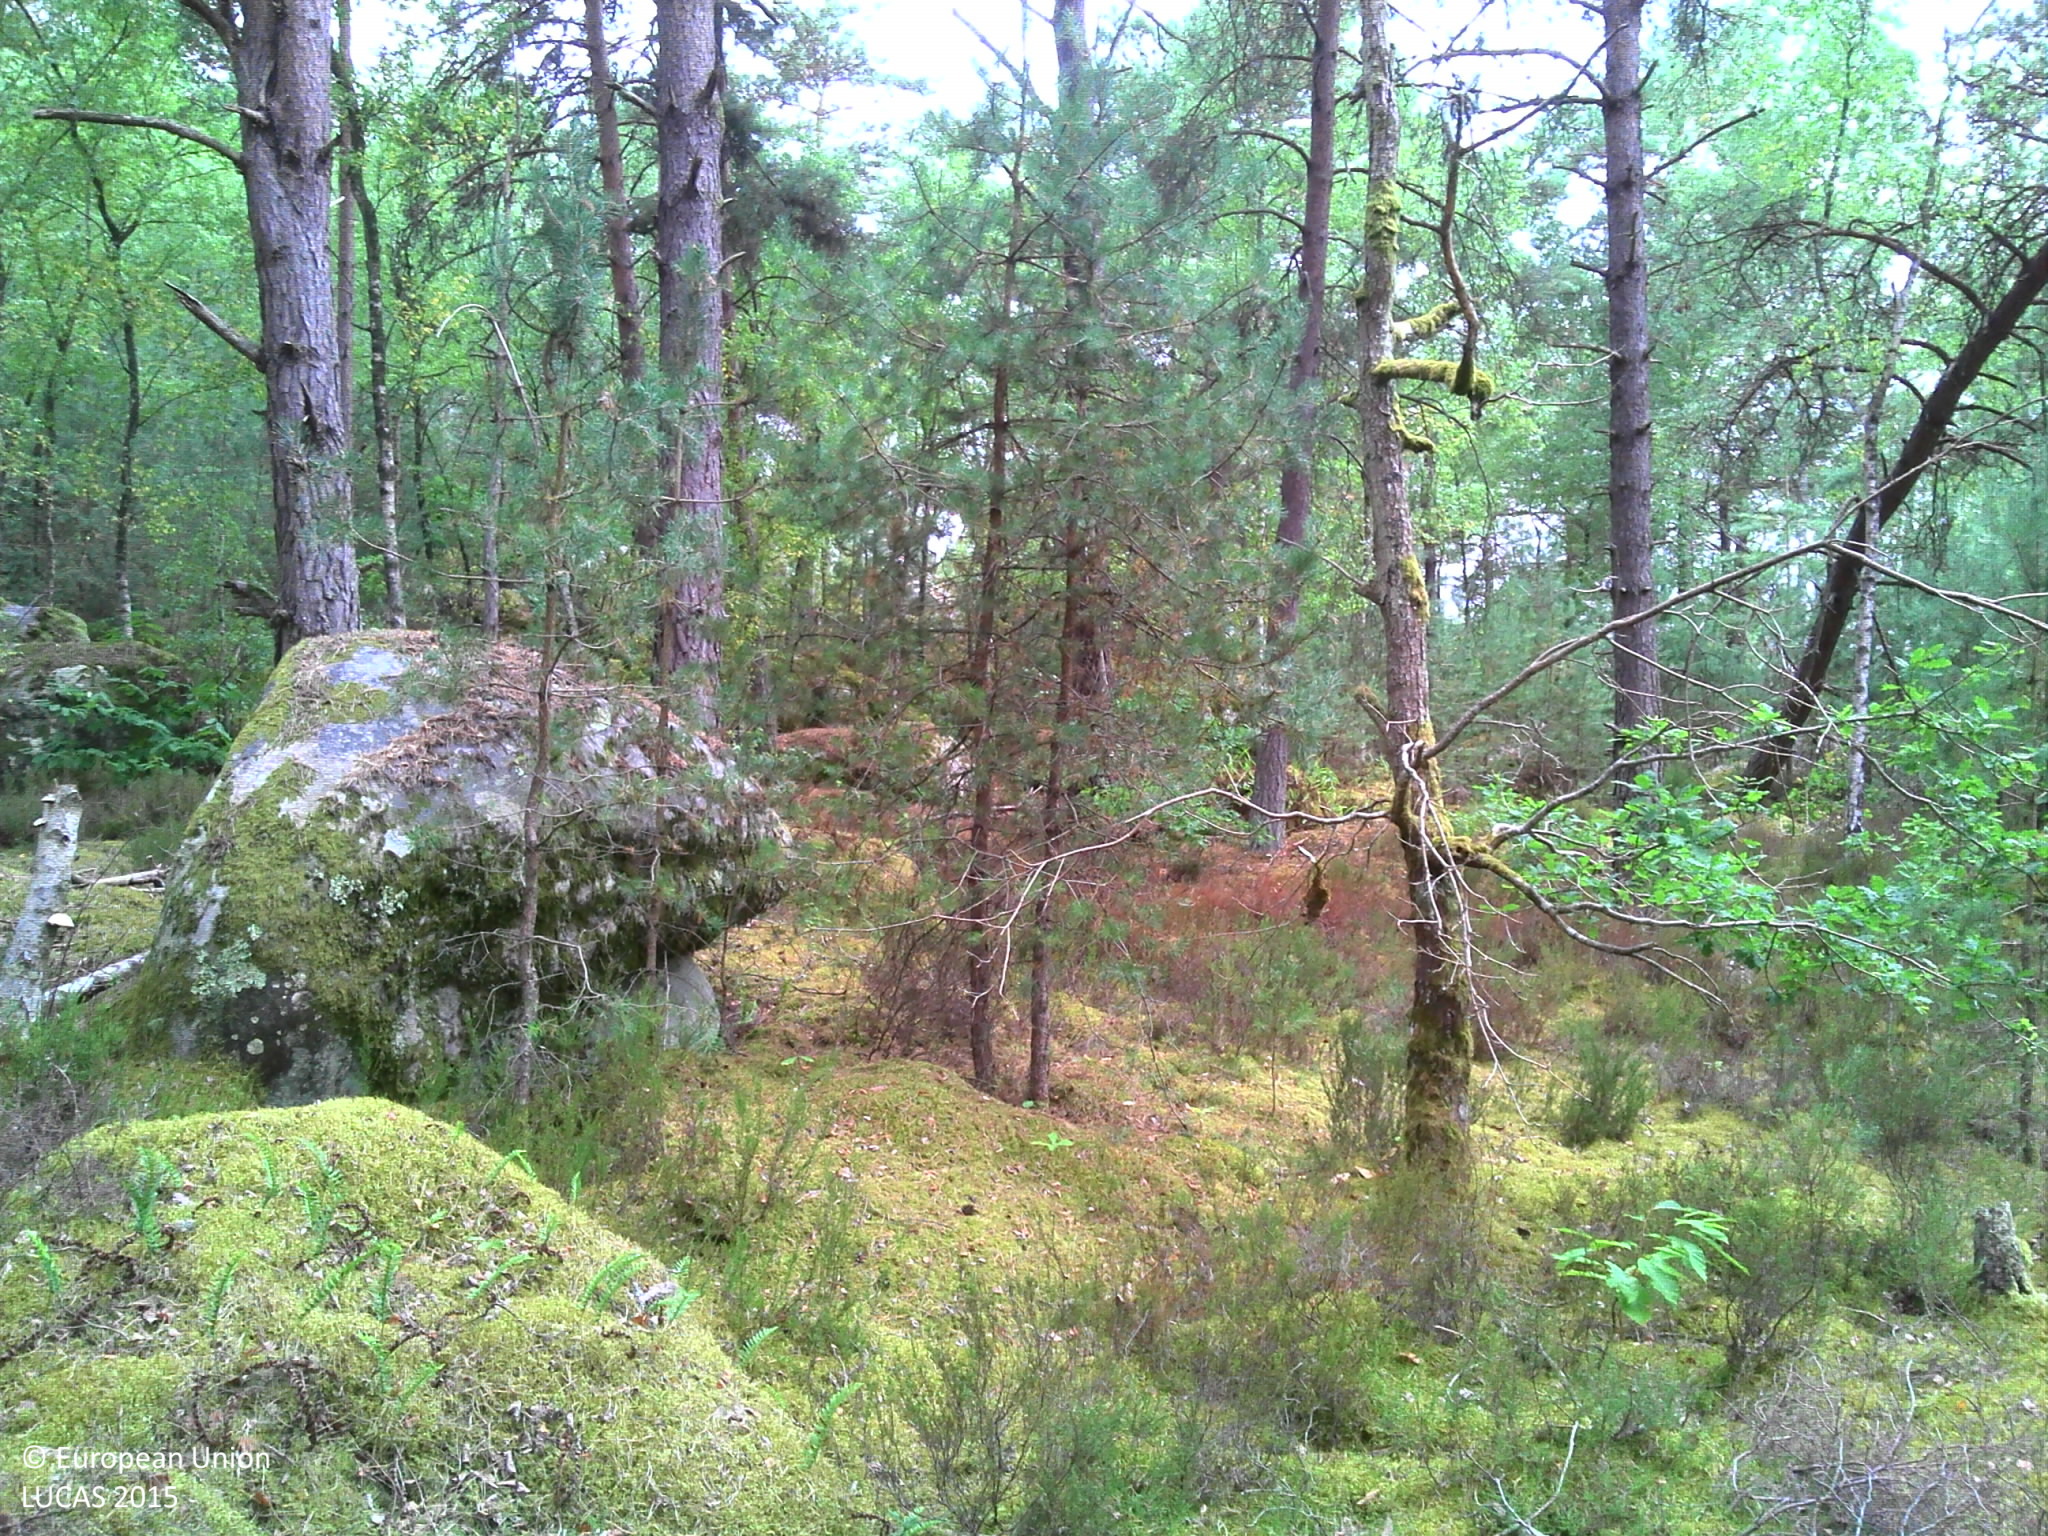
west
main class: Woodland
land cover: Pine dominated mixed woodland
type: non-riverine alder, birch or aspen forest
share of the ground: > 75 %
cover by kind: lichens and mosses 40 %, coniferous forest trees 30 %, shrubs 20 %, broadleaved forest trees 10 %
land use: Forestry
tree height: > 5 m
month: August
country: FR
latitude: 48.3671
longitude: 2.5251
